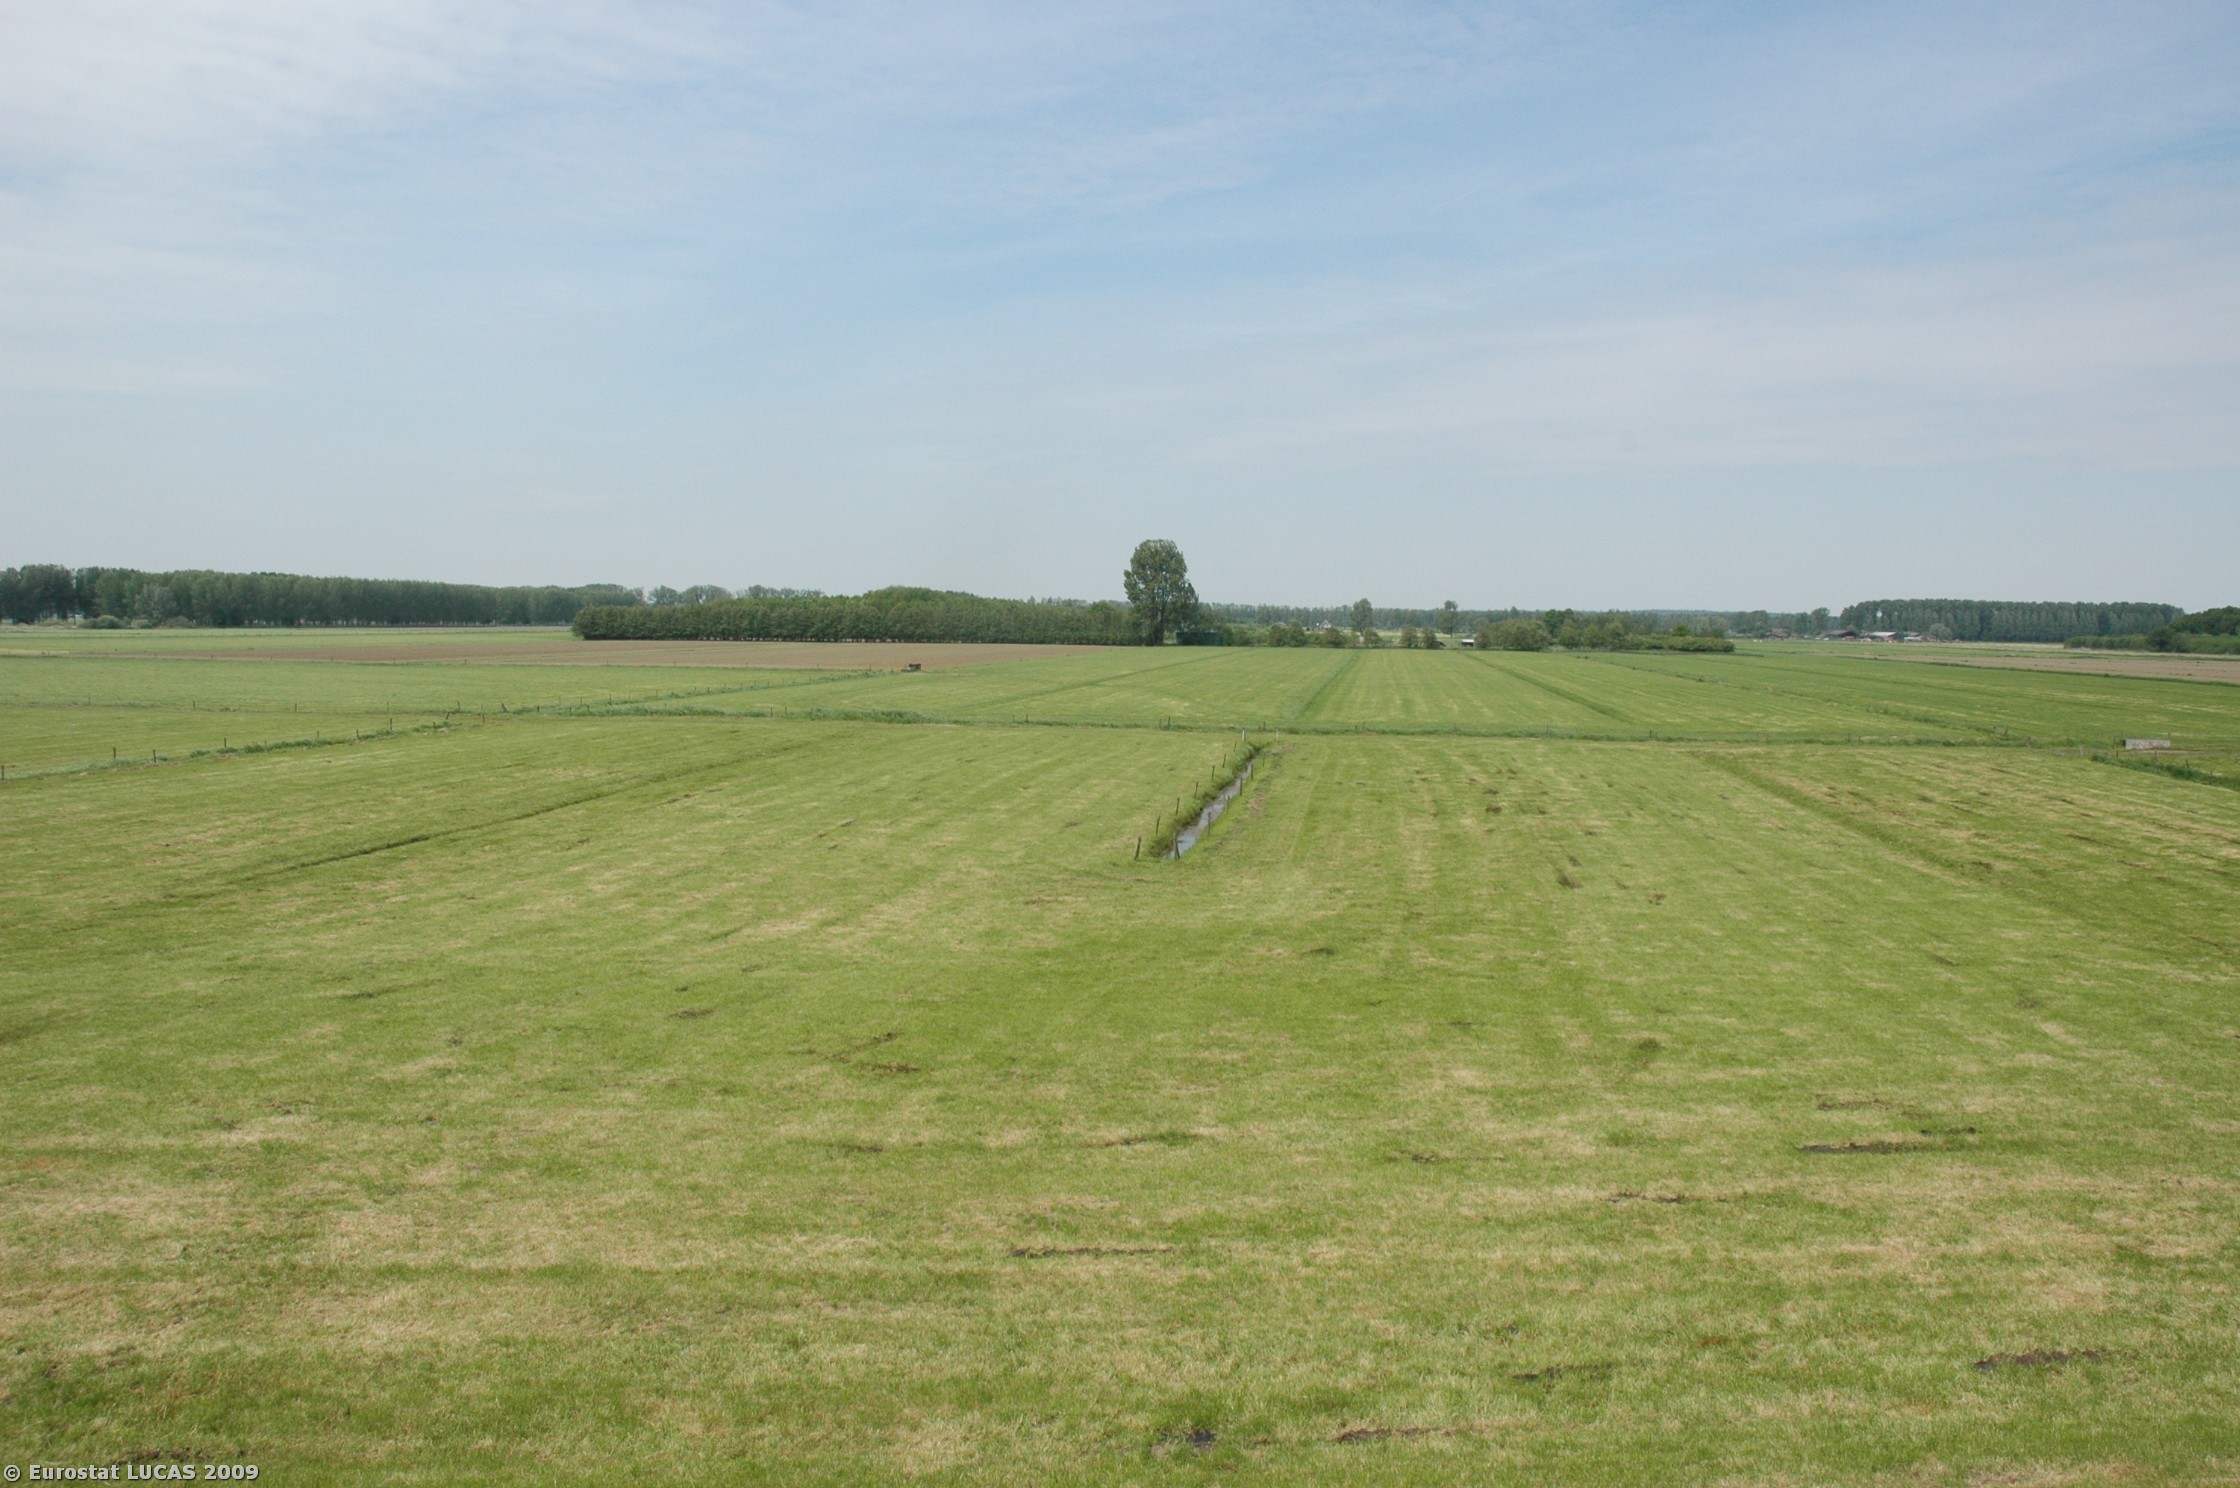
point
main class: Grassland
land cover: Grassland without tree/shrub cover
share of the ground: > 75 %
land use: Agriculture (excluding fallow land and kitchen gardens)
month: May
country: NL
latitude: 51.9828
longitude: 5.4116
